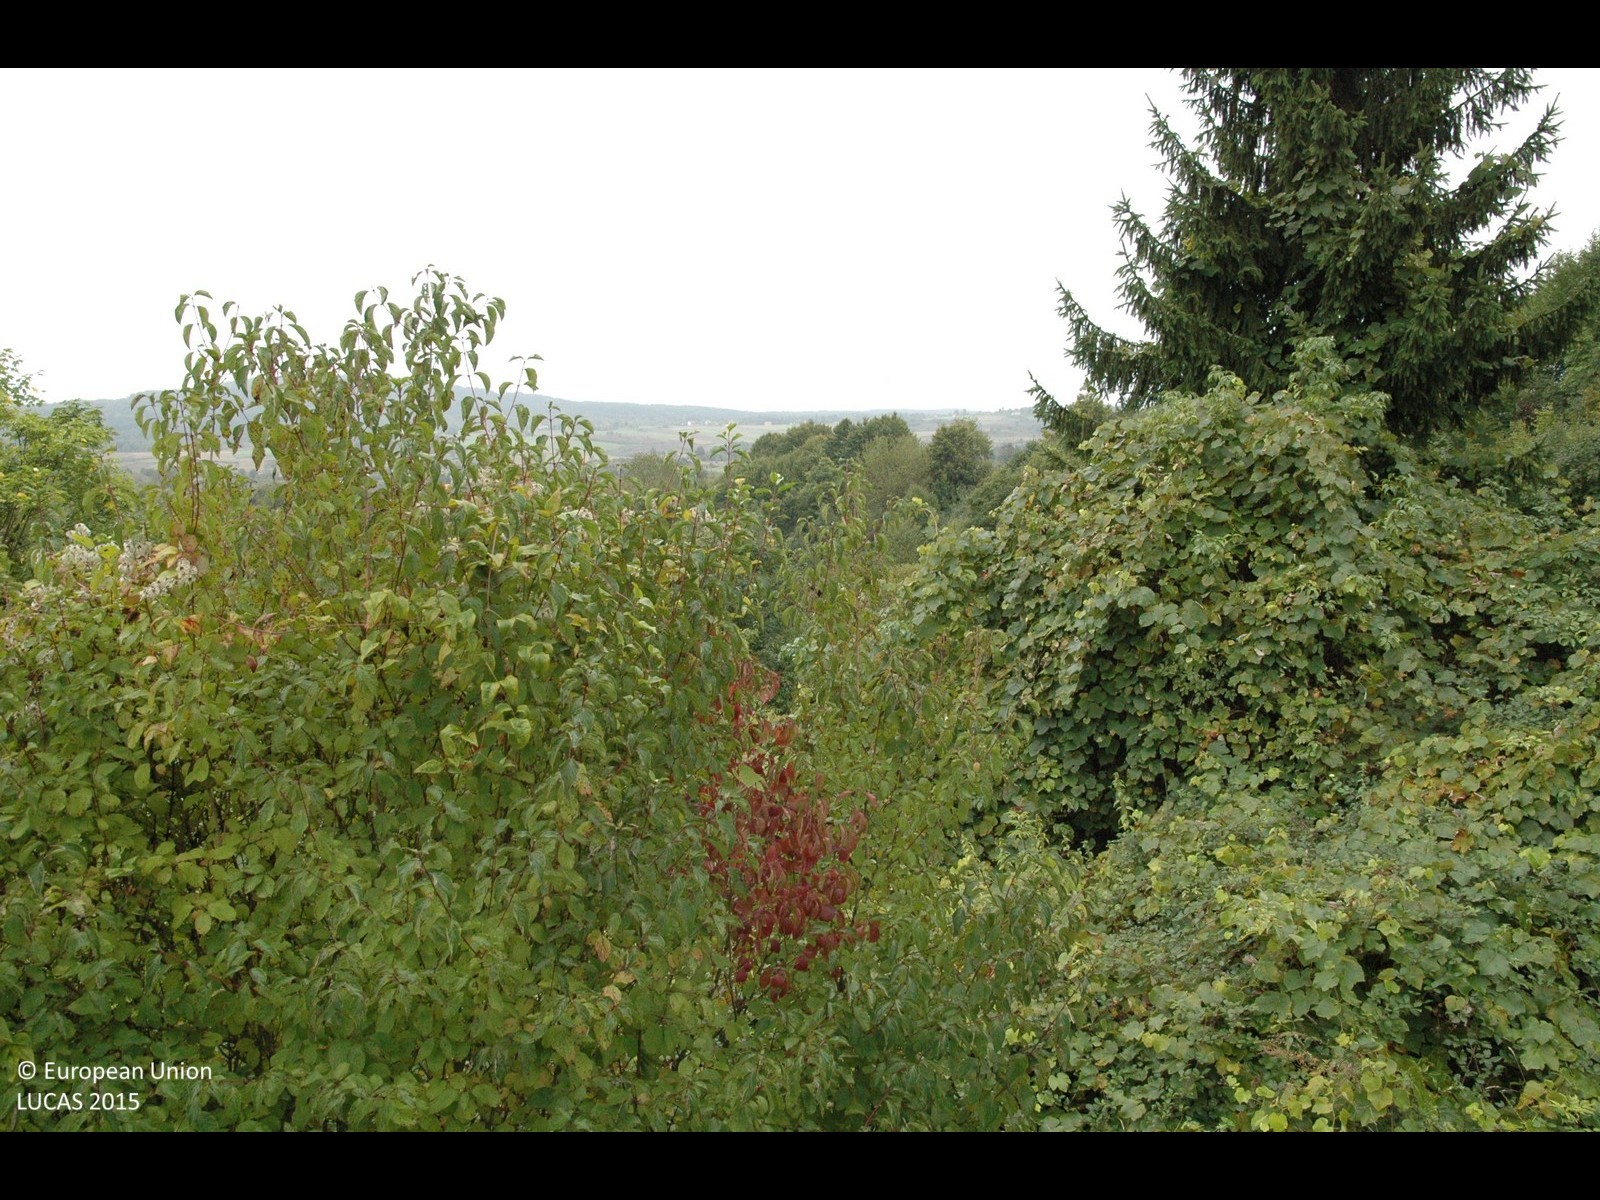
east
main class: Shrubland
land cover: Shrubland with sparse tree cover
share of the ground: > 75 %
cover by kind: shrubs 95 %, broadleaved forest trees 5 %
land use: Semi-natural and natural areas not in use
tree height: > 5 m
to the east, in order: Shrubland with sparse tree cover
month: September
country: HR
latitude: 45.0103
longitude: 15.6412
